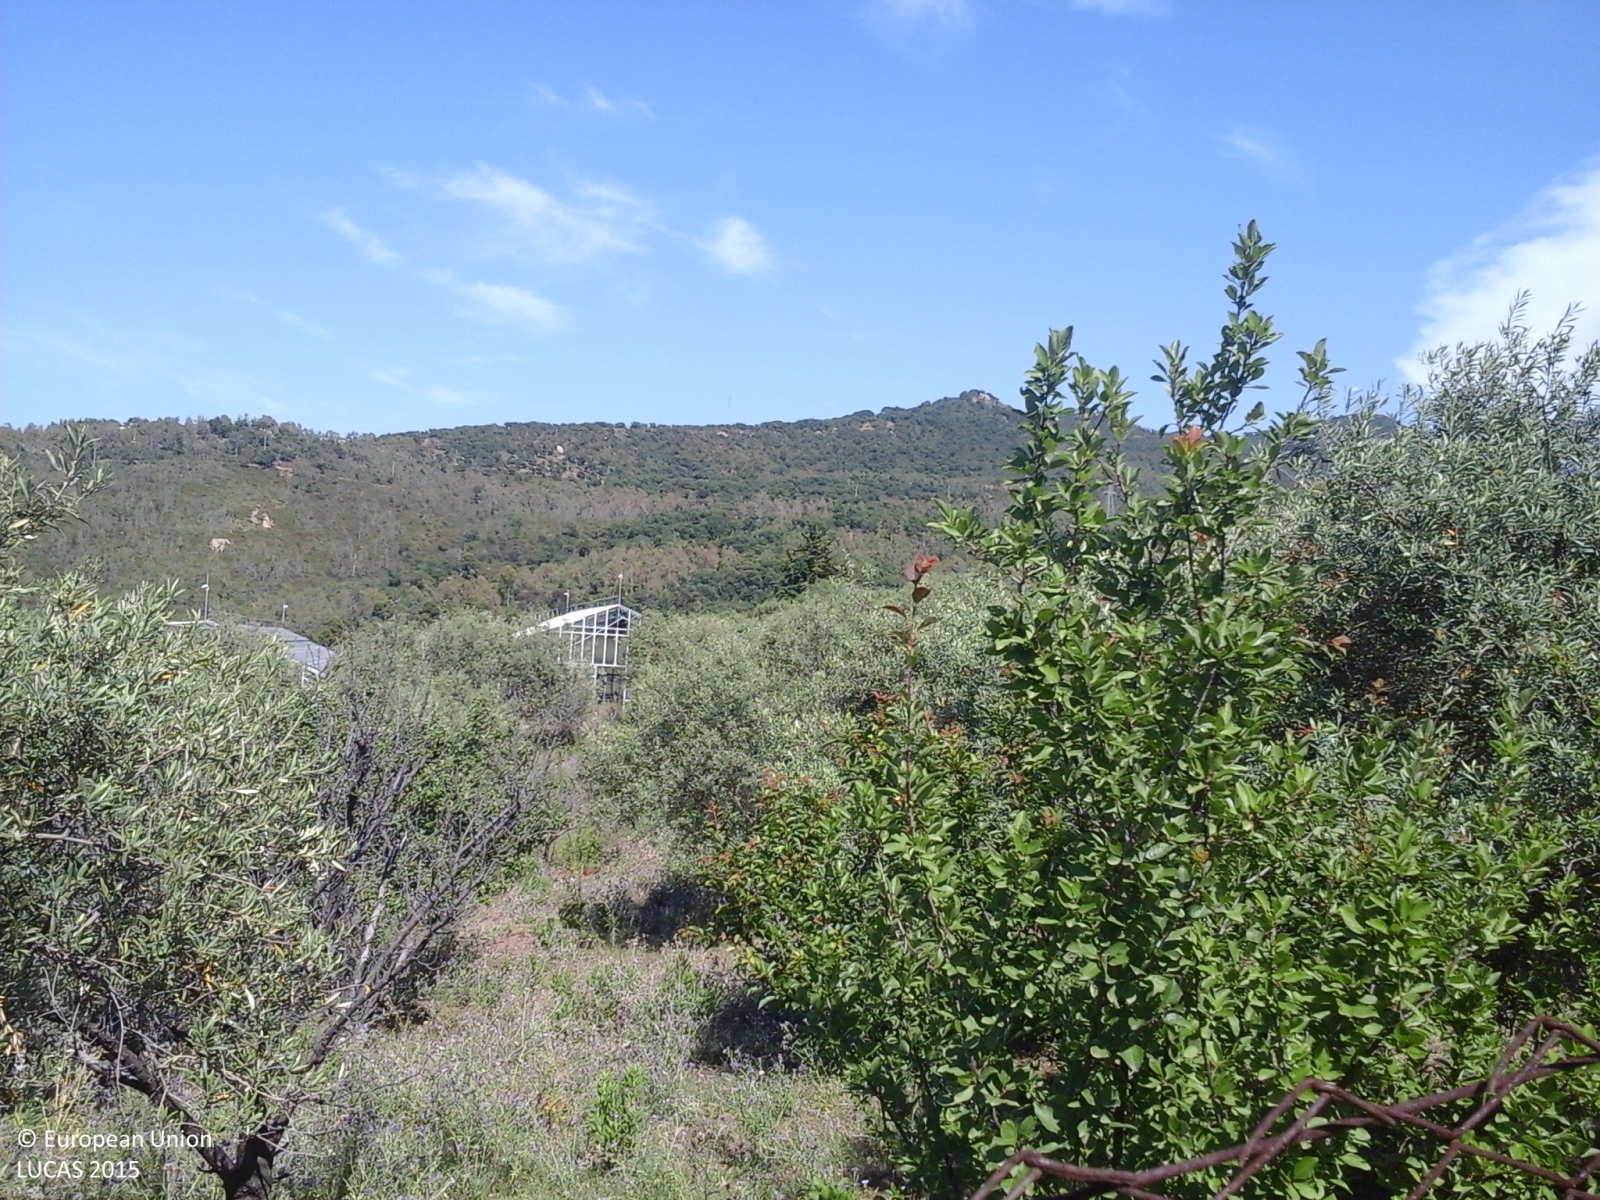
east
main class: Cropland
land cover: Olive groves
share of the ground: 50 - 75 %
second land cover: Spontaneously vegetated surfaces
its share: > 75 %
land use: Agriculture (excluding fallow land and kitchen gardens)
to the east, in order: Olive groves; Spontaneously vegetated surfaces; Artificial constructions in urban areas; Permanent crops (only in case pi); Fences; Permanent crops (only in case pi); Tracks; Permanent crops (only in case pi); Shrubland with sparse tree cover
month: June
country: IT
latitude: 37.9927
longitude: 13.9465
